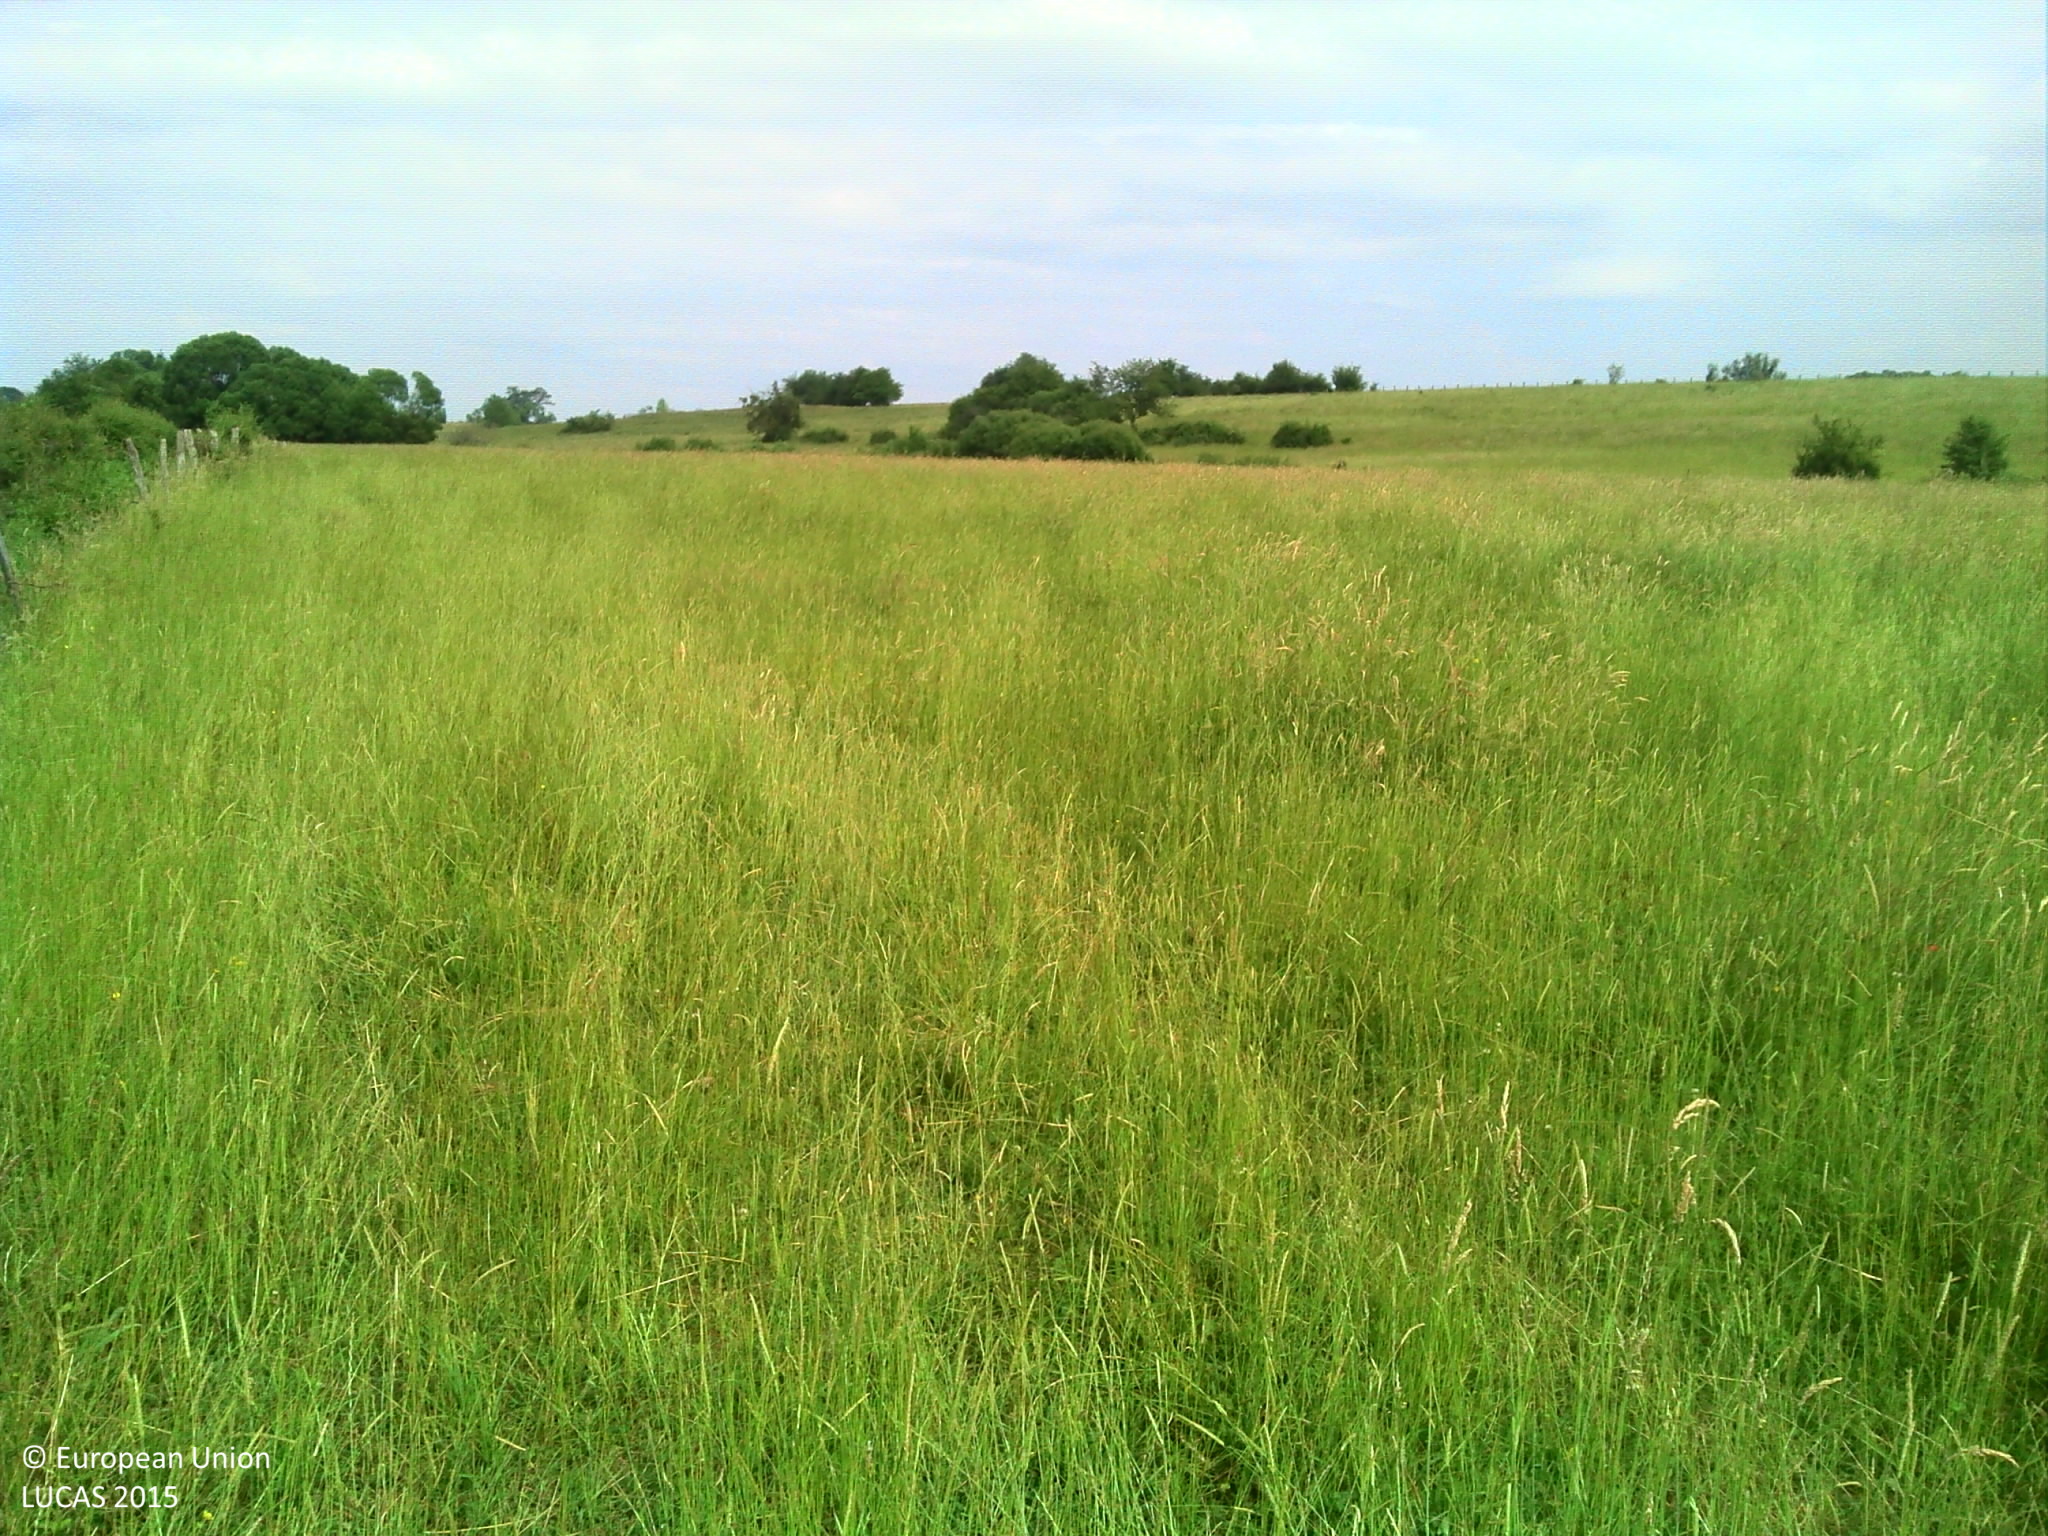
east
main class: Grassland
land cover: Grassland without tree/shrub cover
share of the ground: > 75 %
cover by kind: herbaceous plants 100 %
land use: Agriculture (excluding fallow land and kitchen gardens)
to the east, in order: Ditches and canals; Abandoned hedges; Fences; Grassland without tree/shrub cover; Managed hedges; Ditches and canals; Grassland without tree/shrub cover; Abandoned hedges; Grassland without tree/shrub cover
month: June
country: FR
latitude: 47.7806
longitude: 6.2241
